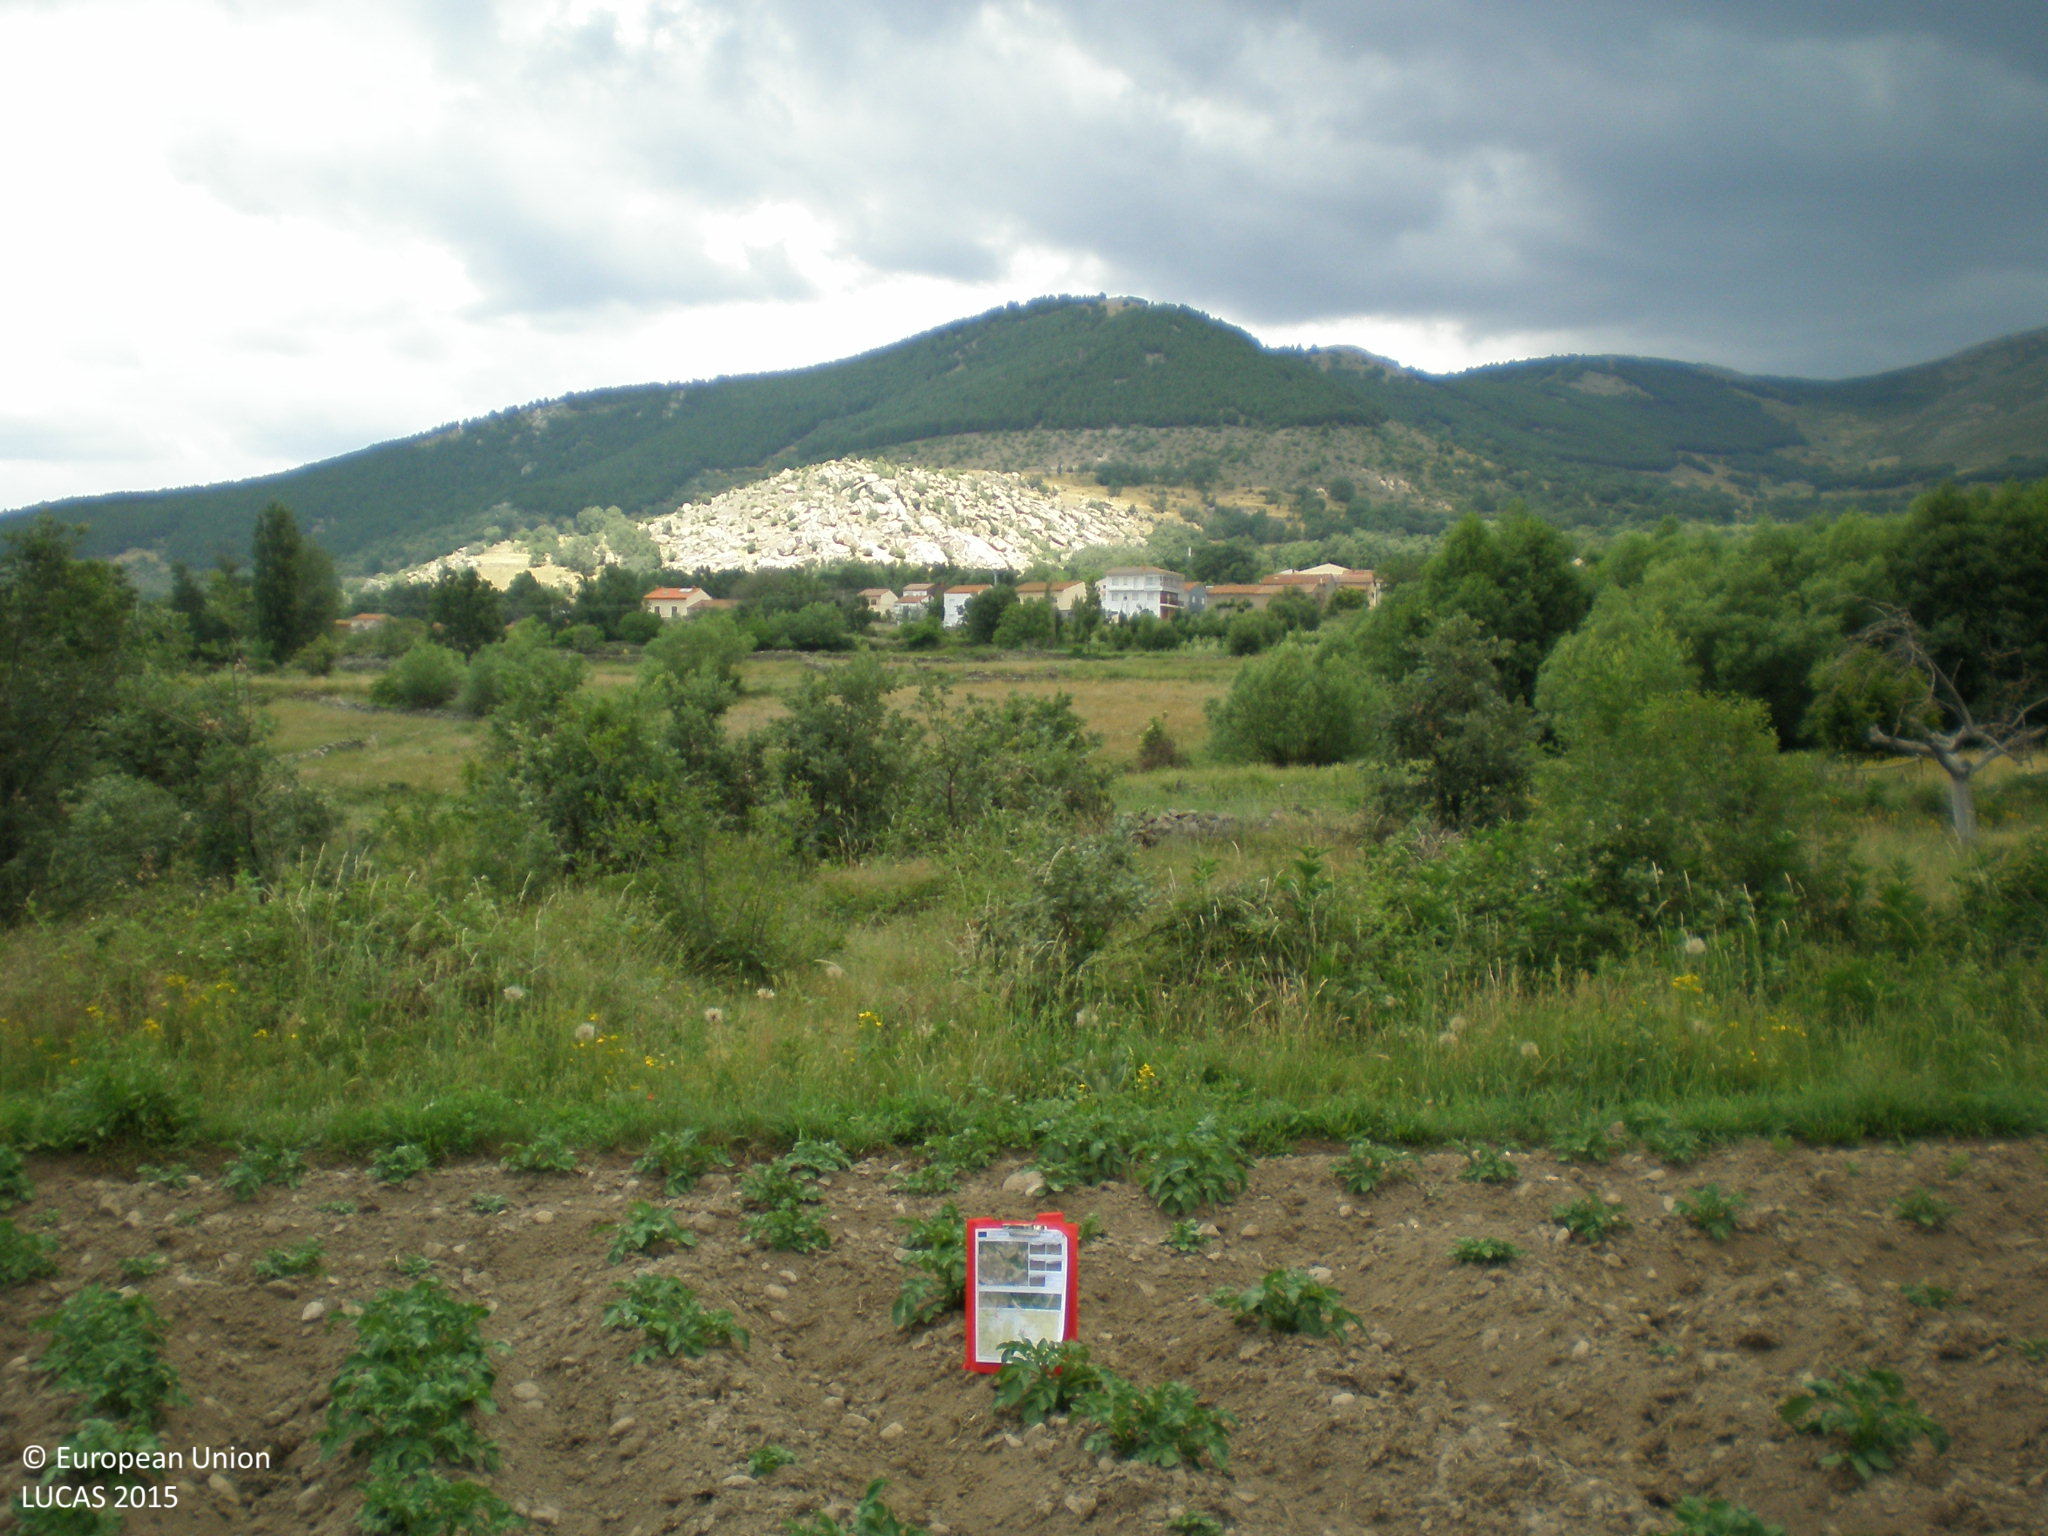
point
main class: Cropland
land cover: Potatoes
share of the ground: < 10 %
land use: Agriculture (excluding fallow land and kitchen gardens)
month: June
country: ES
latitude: 40.2760
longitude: -5.5060
